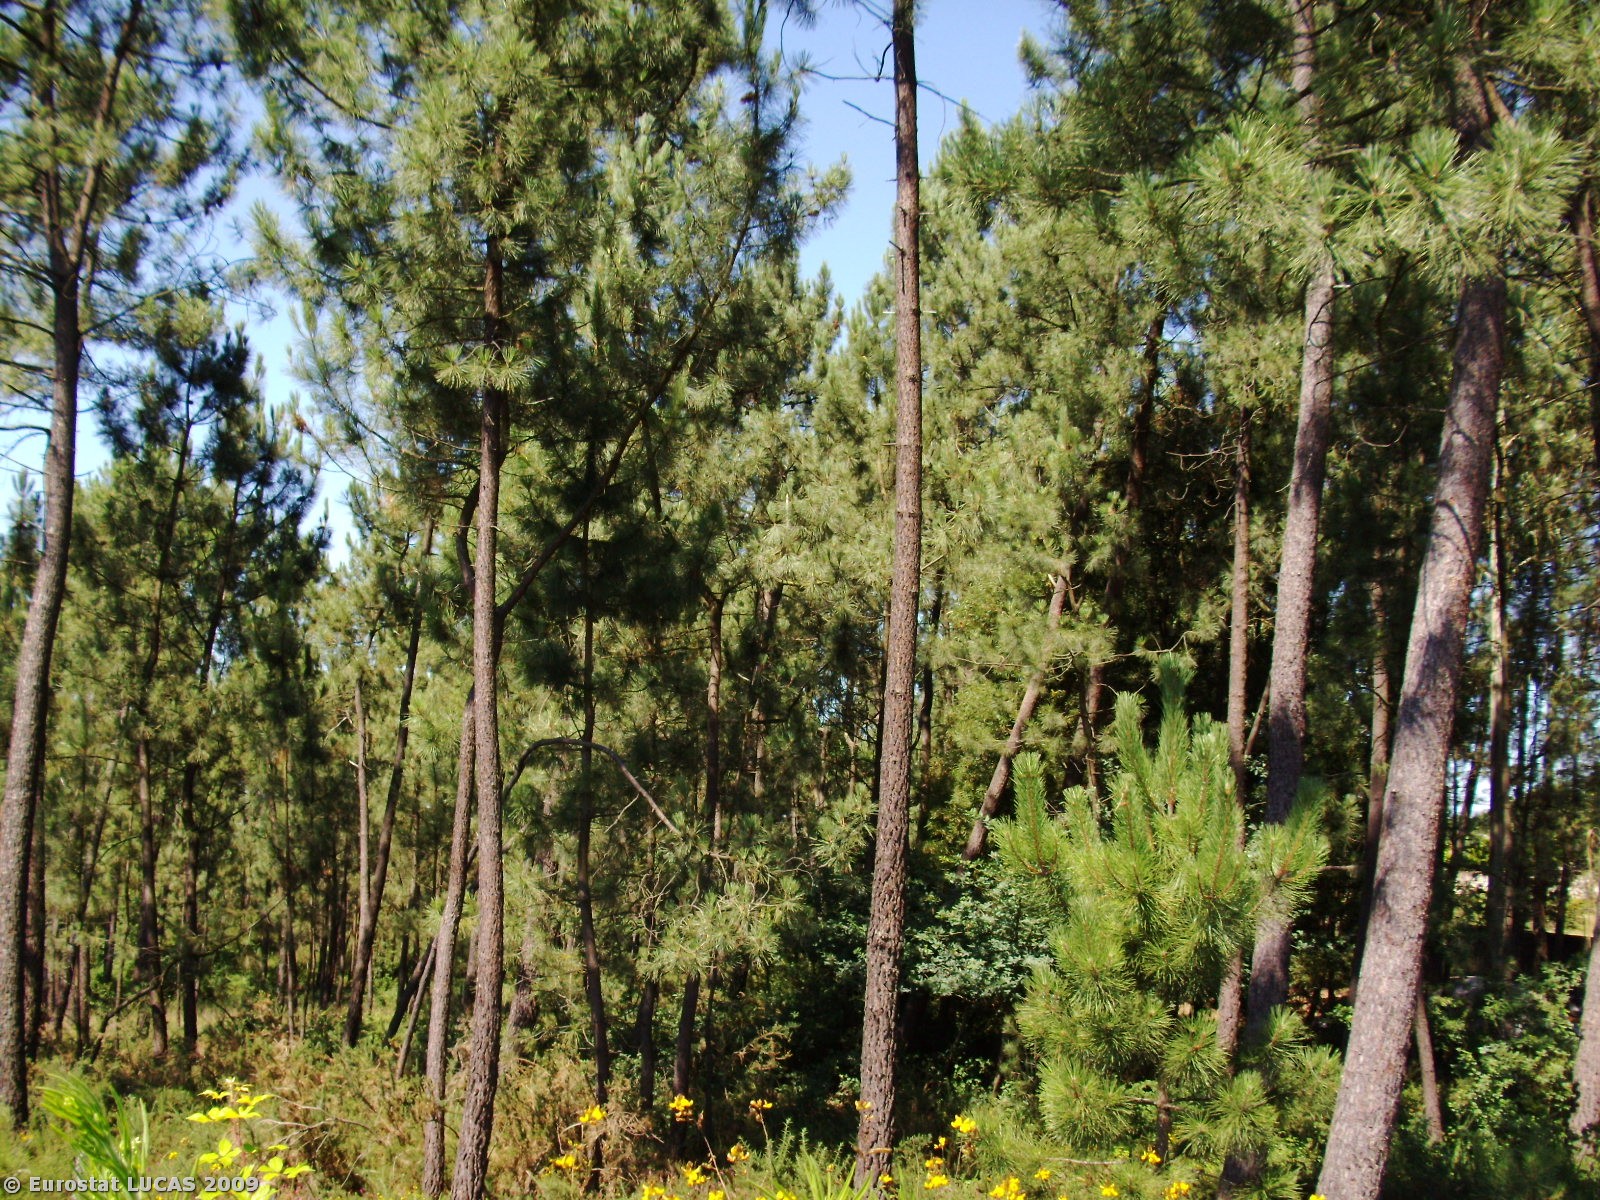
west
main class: Grassland
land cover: Spontaneously vegetated surfaces
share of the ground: 50 - 75 %
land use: Forestry
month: July
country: PT
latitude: 41.5579
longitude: -8.5135
